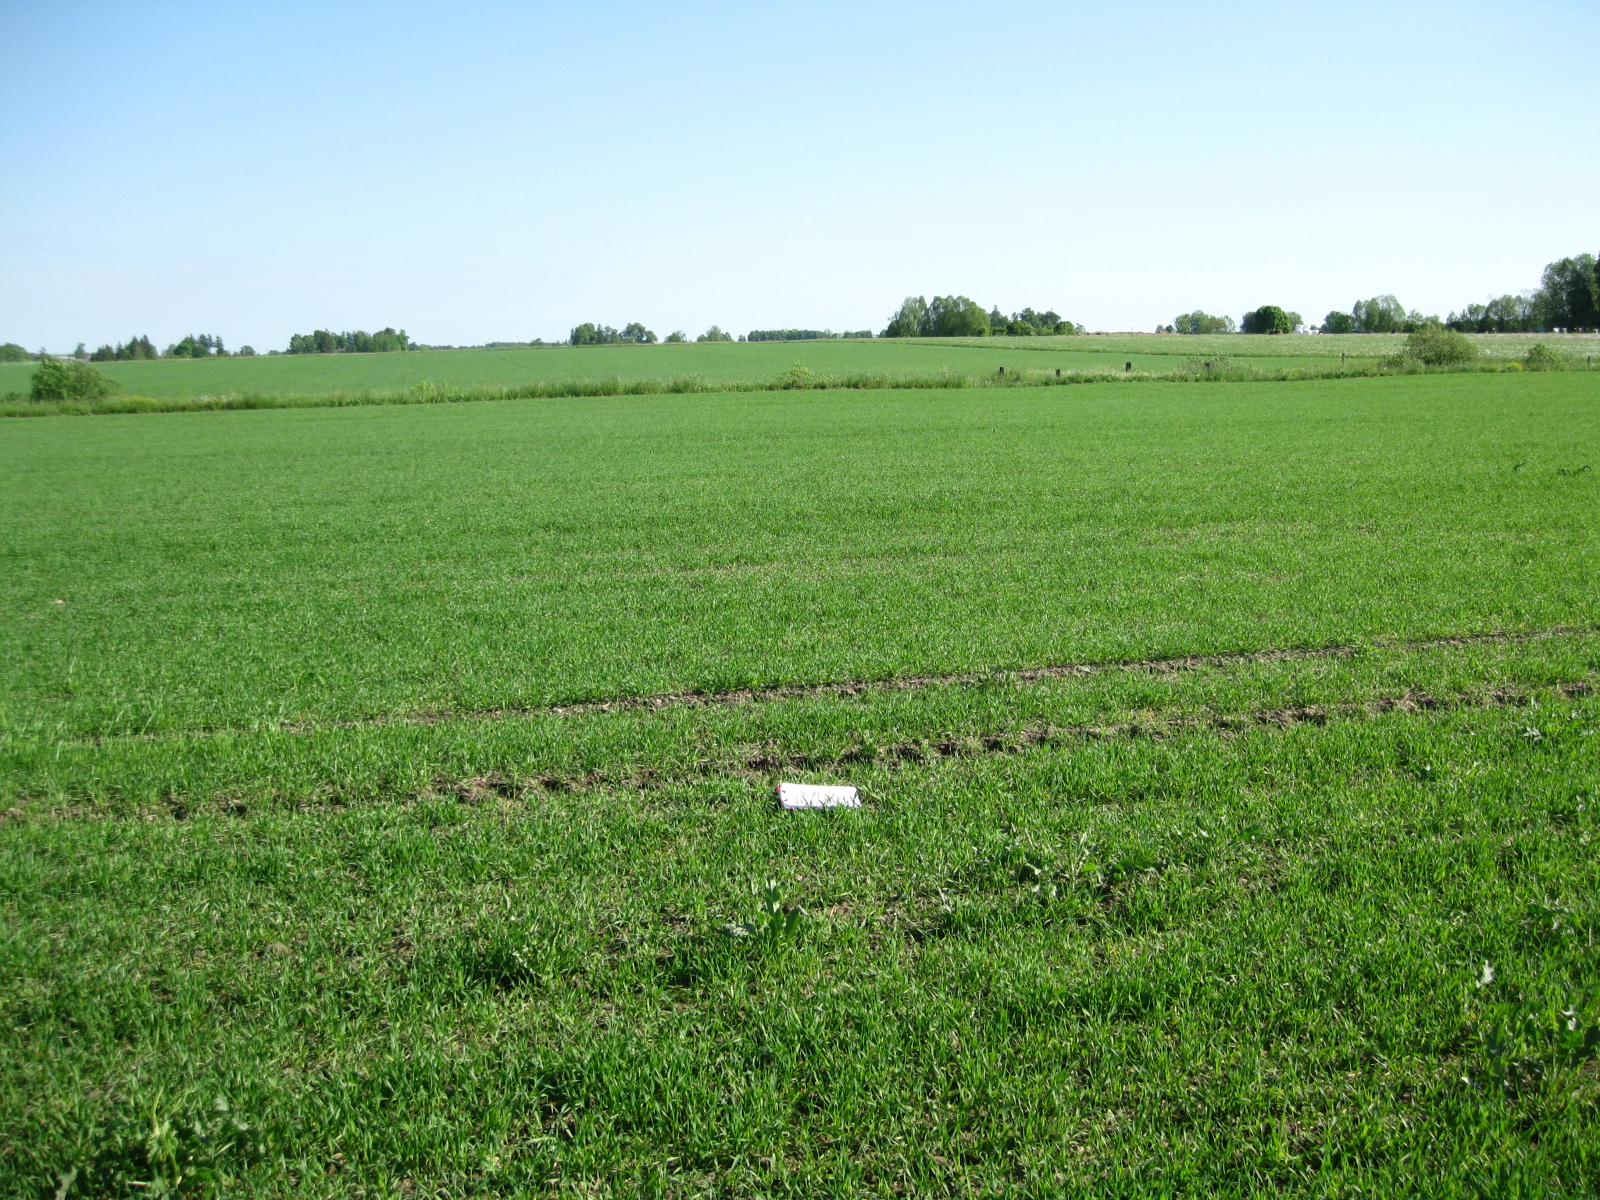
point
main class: Cropland
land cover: Barley
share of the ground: 50 - 75 %
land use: Agriculture (excluding fallow land and kitchen gardens)
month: May
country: LT
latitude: 55.8869
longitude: 24.8312
